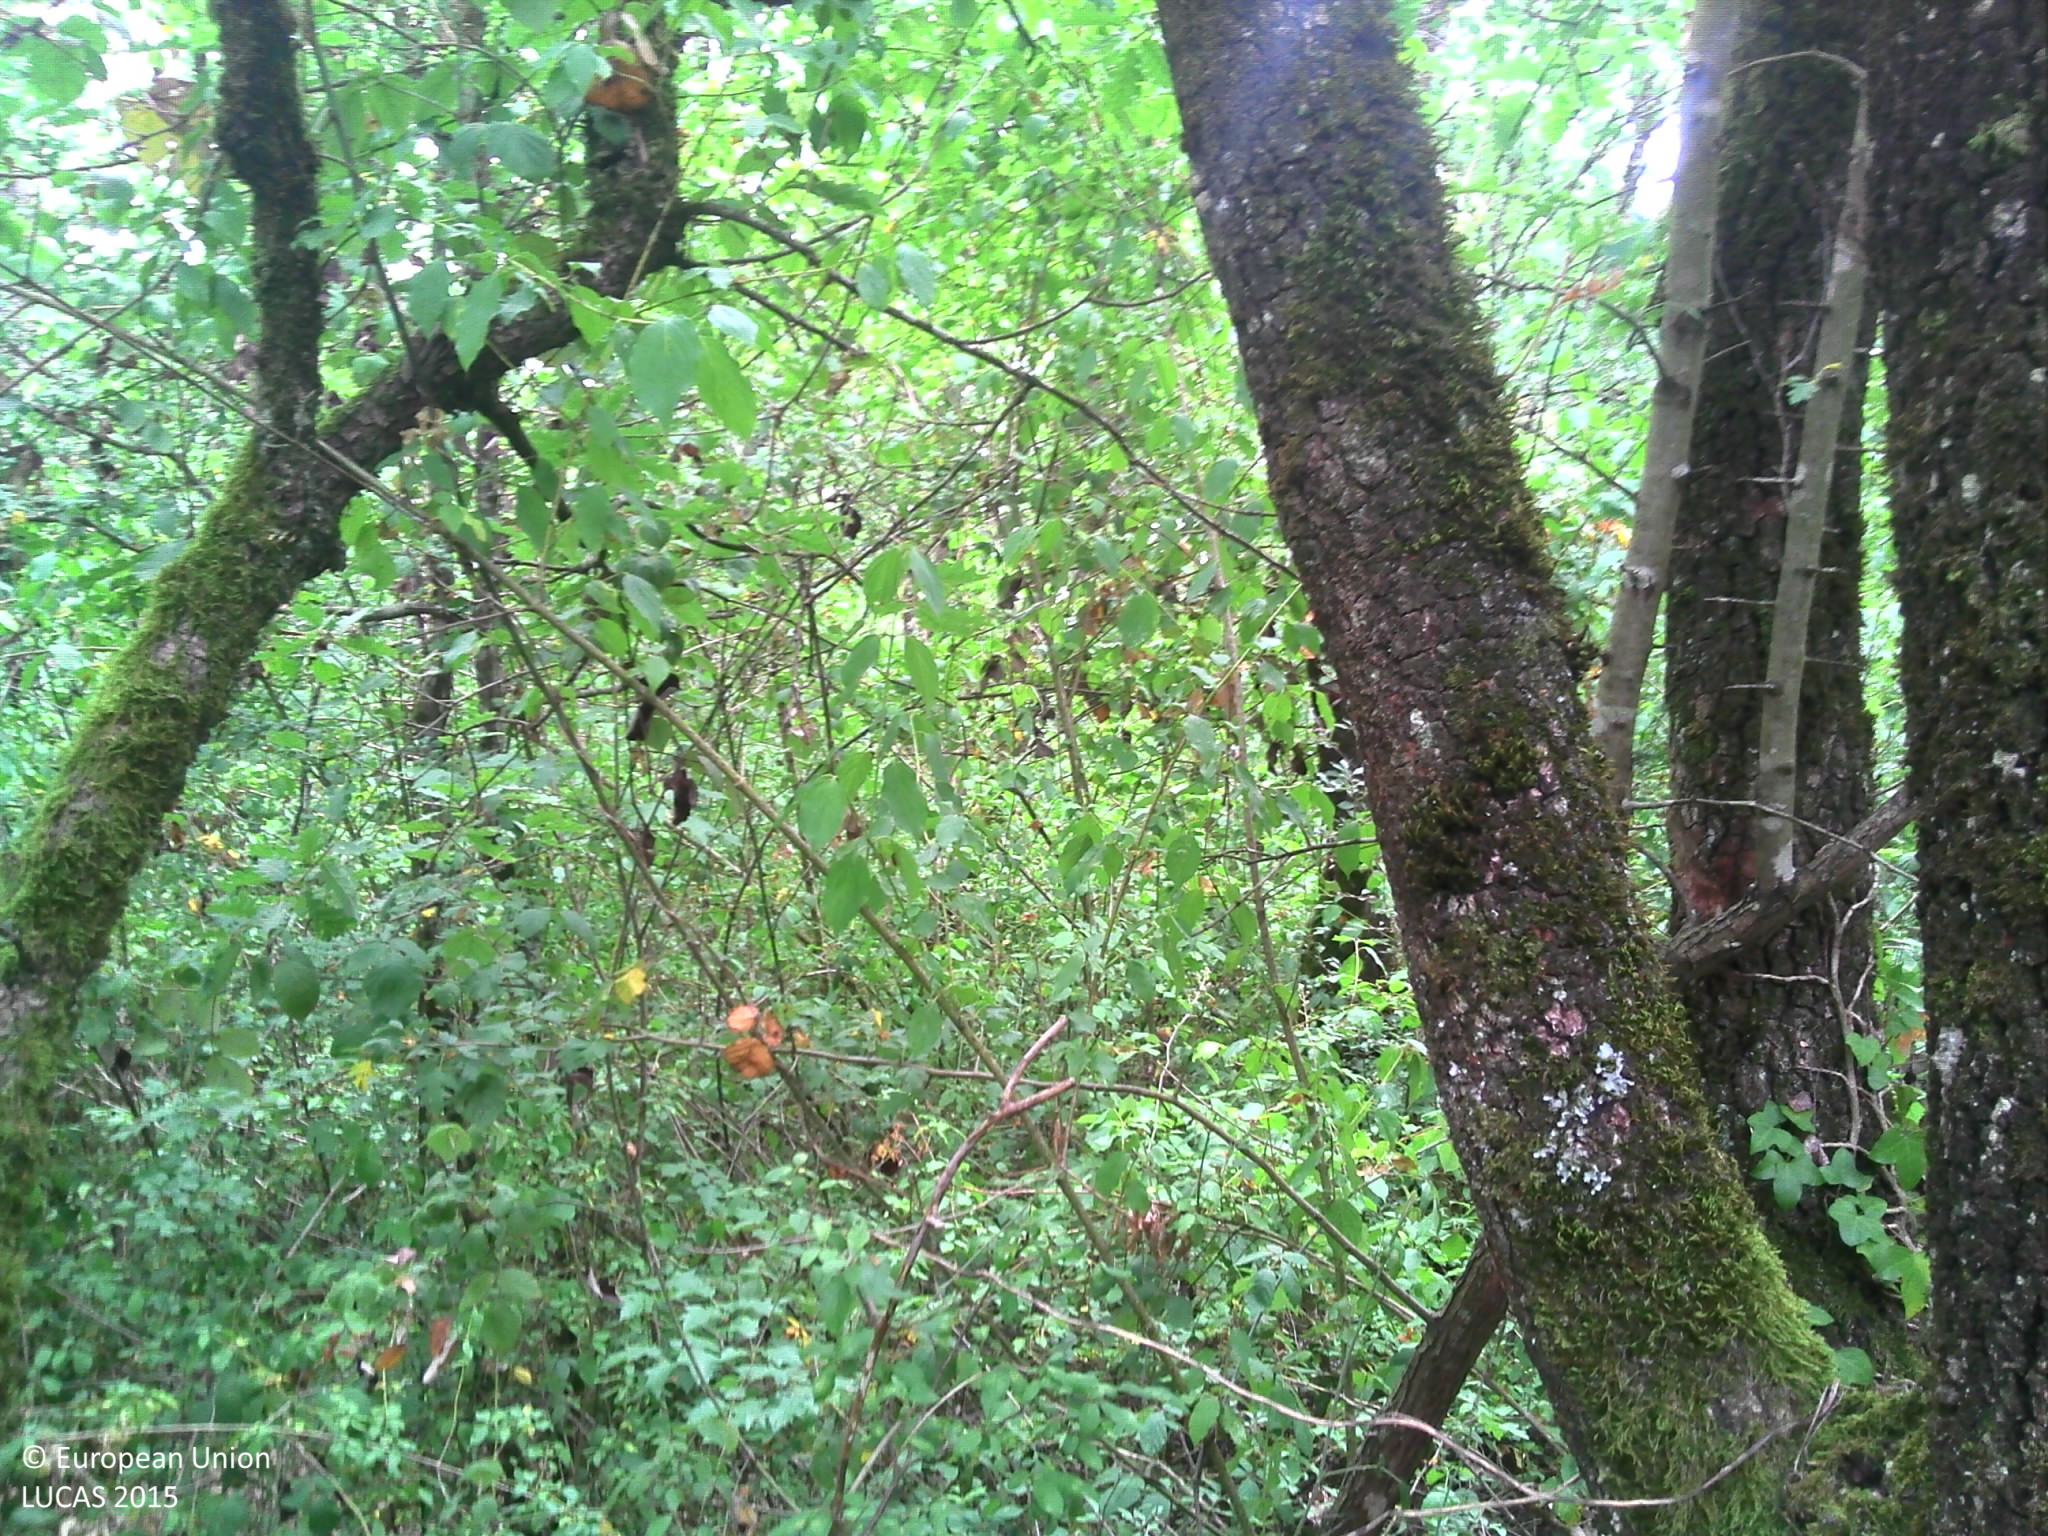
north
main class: Woodland
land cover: Broadleaved woodland
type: mesophytic deciduous forest
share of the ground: > 75 %
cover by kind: broadleaved forest trees 85 %, herbaceous plants 10 %, shrubs 5 %
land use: Forestry
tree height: > 5 m
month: July
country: FR
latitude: 43.8976
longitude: 0.9226
